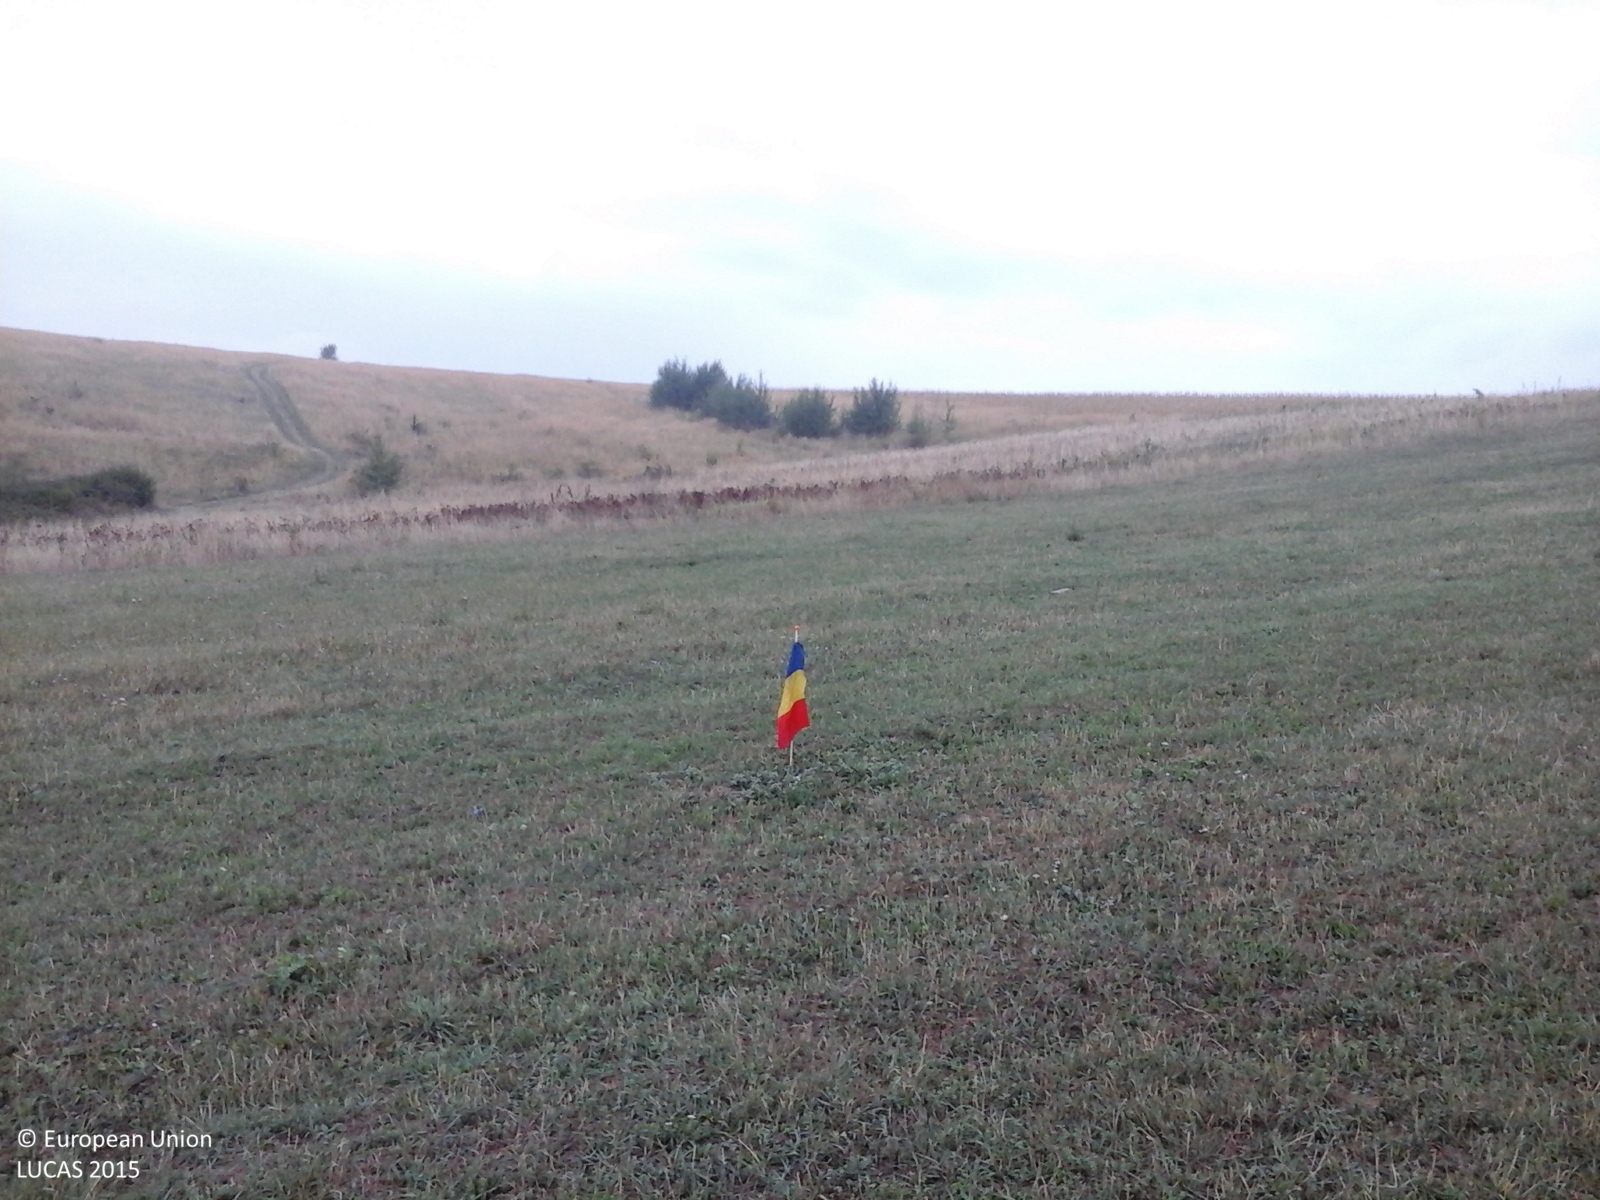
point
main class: Grassland
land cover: Grassland without tree/shrub cover
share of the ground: > 75 %
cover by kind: herbaceous plants 100 %
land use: Agriculture (excluding fallow land and kitchen gardens)
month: September
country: RO
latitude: 45.5410
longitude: 22.0394
